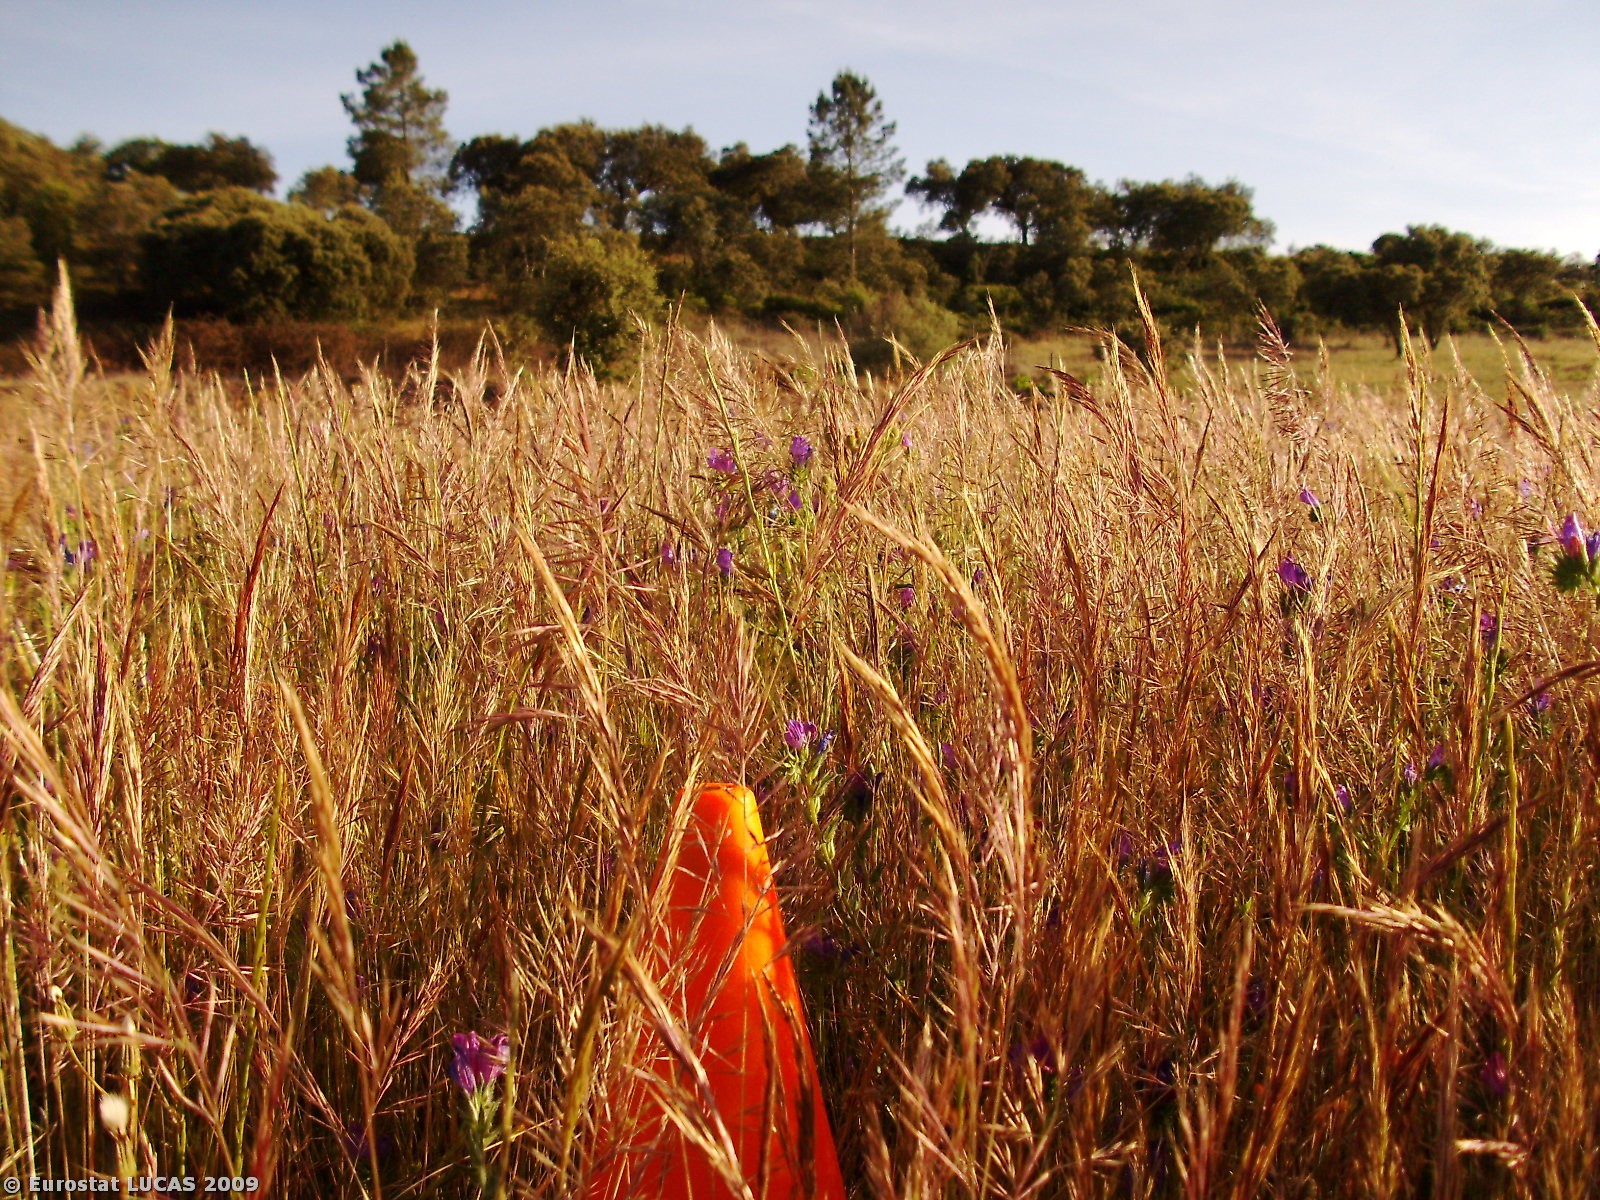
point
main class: Grassland
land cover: Grassland without tree/shrub cover
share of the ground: > 75 %
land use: Agriculture (excluding fallow land and kitchen gardens)
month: May
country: PT
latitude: 39.0984
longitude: -8.0326
